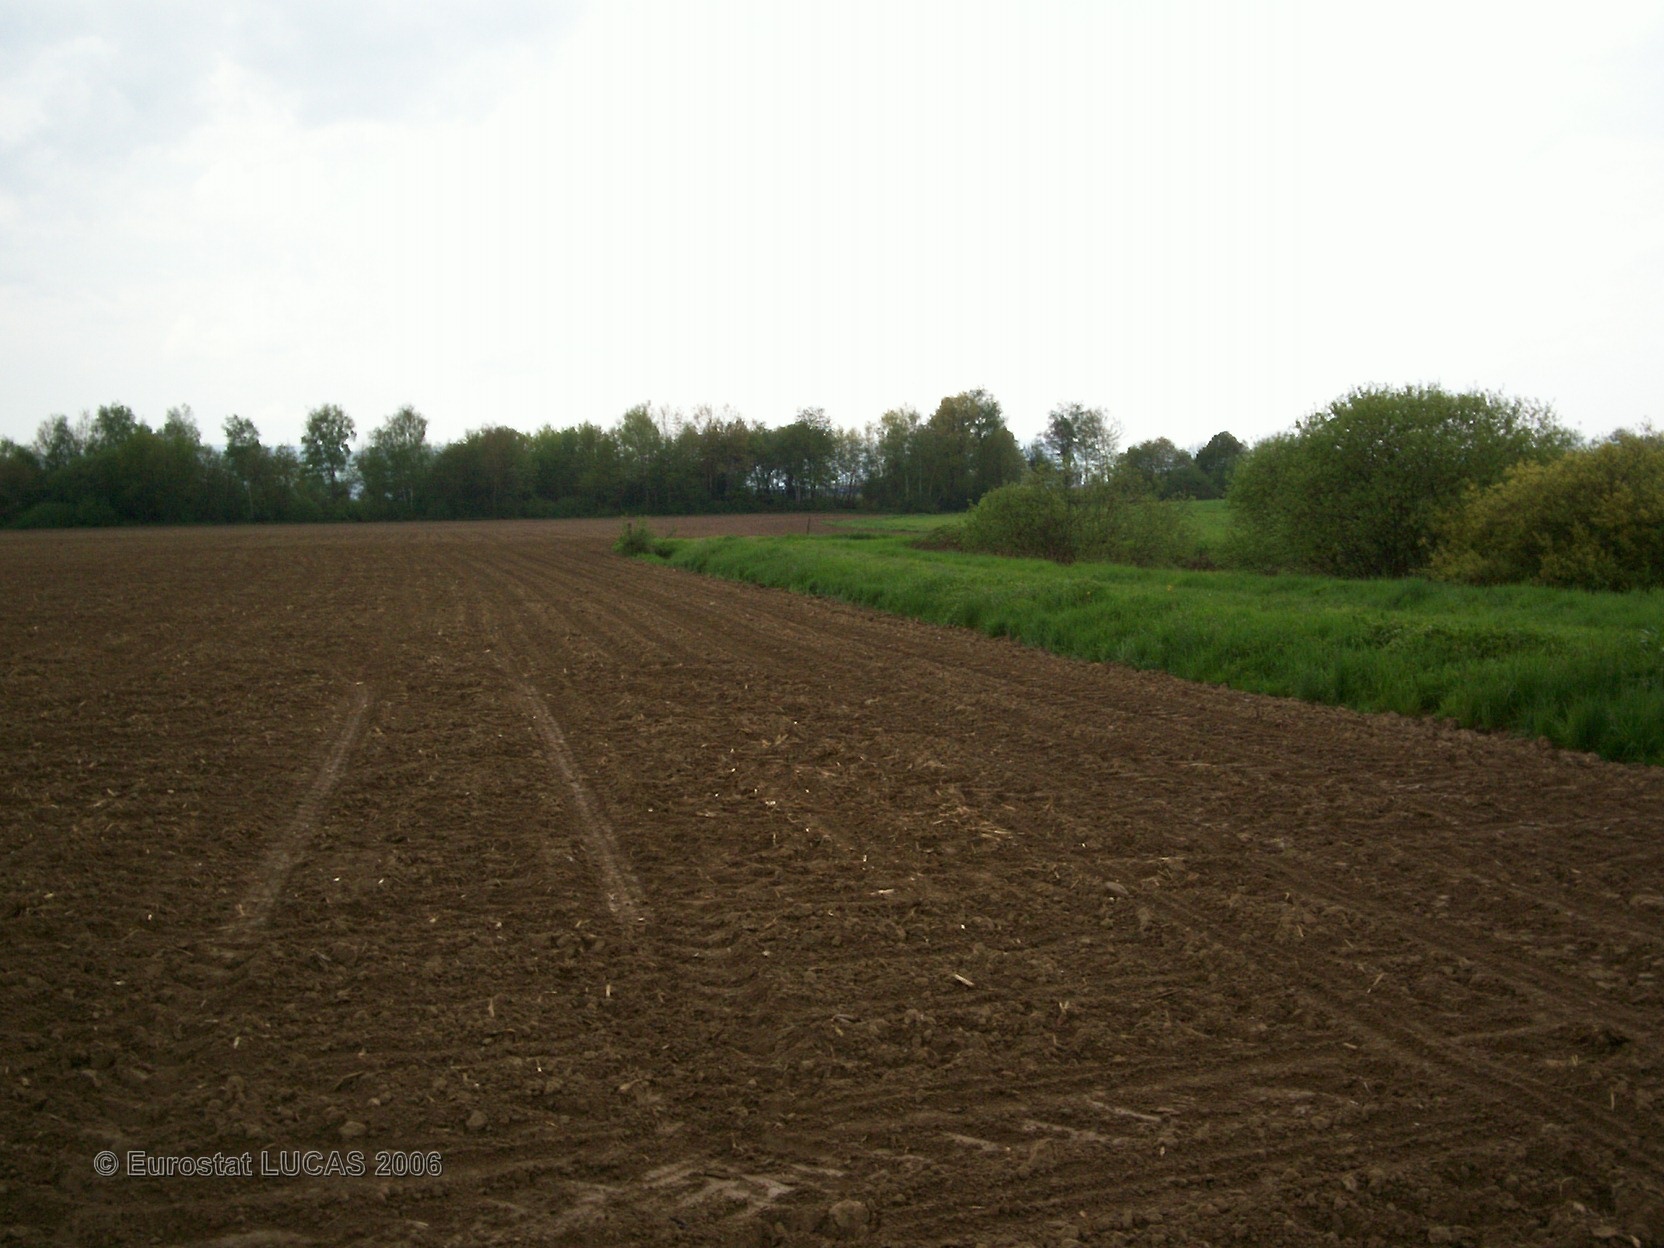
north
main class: Cropland
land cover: Maize
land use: Agriculture (excluding fallow land and kitchen gardens)
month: May
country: FR
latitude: 47.6426
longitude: 7.0065
